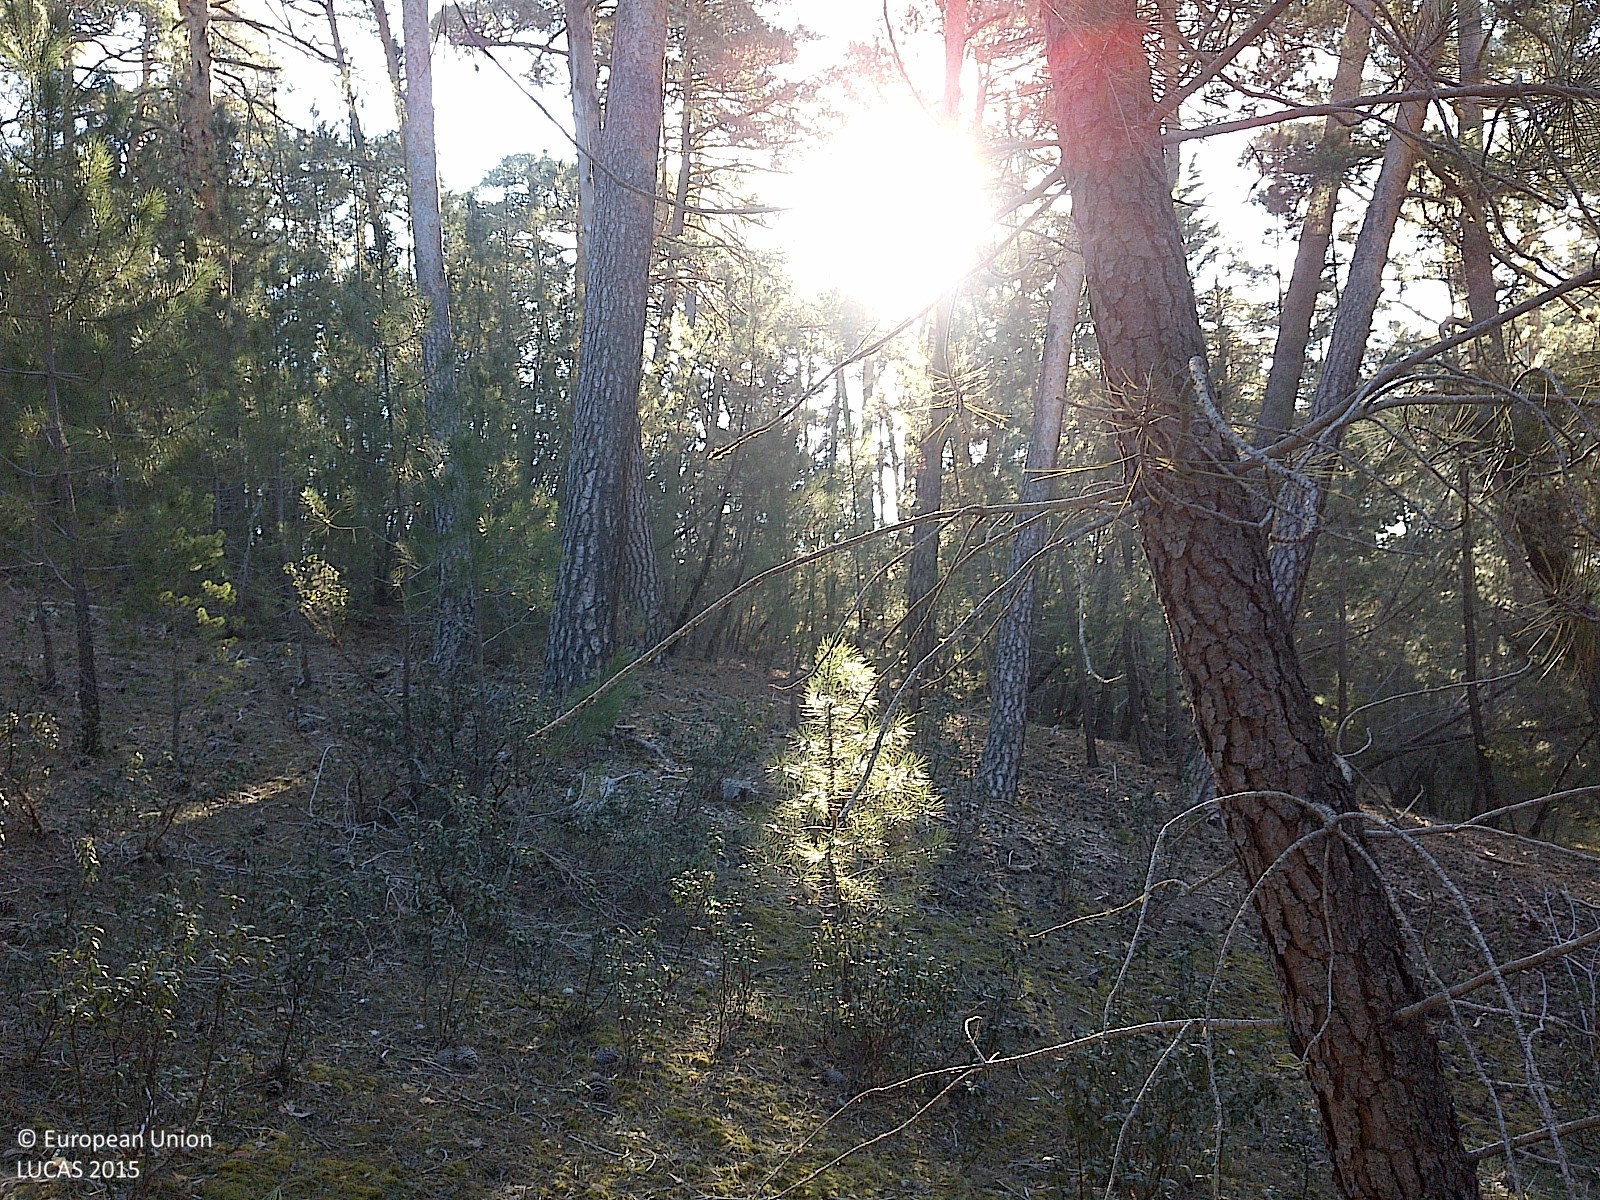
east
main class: Woodland
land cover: Pine dominated coniferous woodland
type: coniferous forest of the mediterranean region
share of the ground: 50 - 75 %
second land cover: Spontaneously vegetated surfaces
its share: 50 - 75 %
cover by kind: coniferous forest trees 85 %, herbaceous plants 10 %, shrubs 5 %
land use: Forestry
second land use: Agriculture (excluding fallow land and kitchen gardens)
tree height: > 5 m
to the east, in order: Pine dominated coniferous woodland; Spontaneously vegetated surfaces; Rivers and streams; Pine dominated coniferous woodland
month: April
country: ES
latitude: 41.8582
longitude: -3.0681
